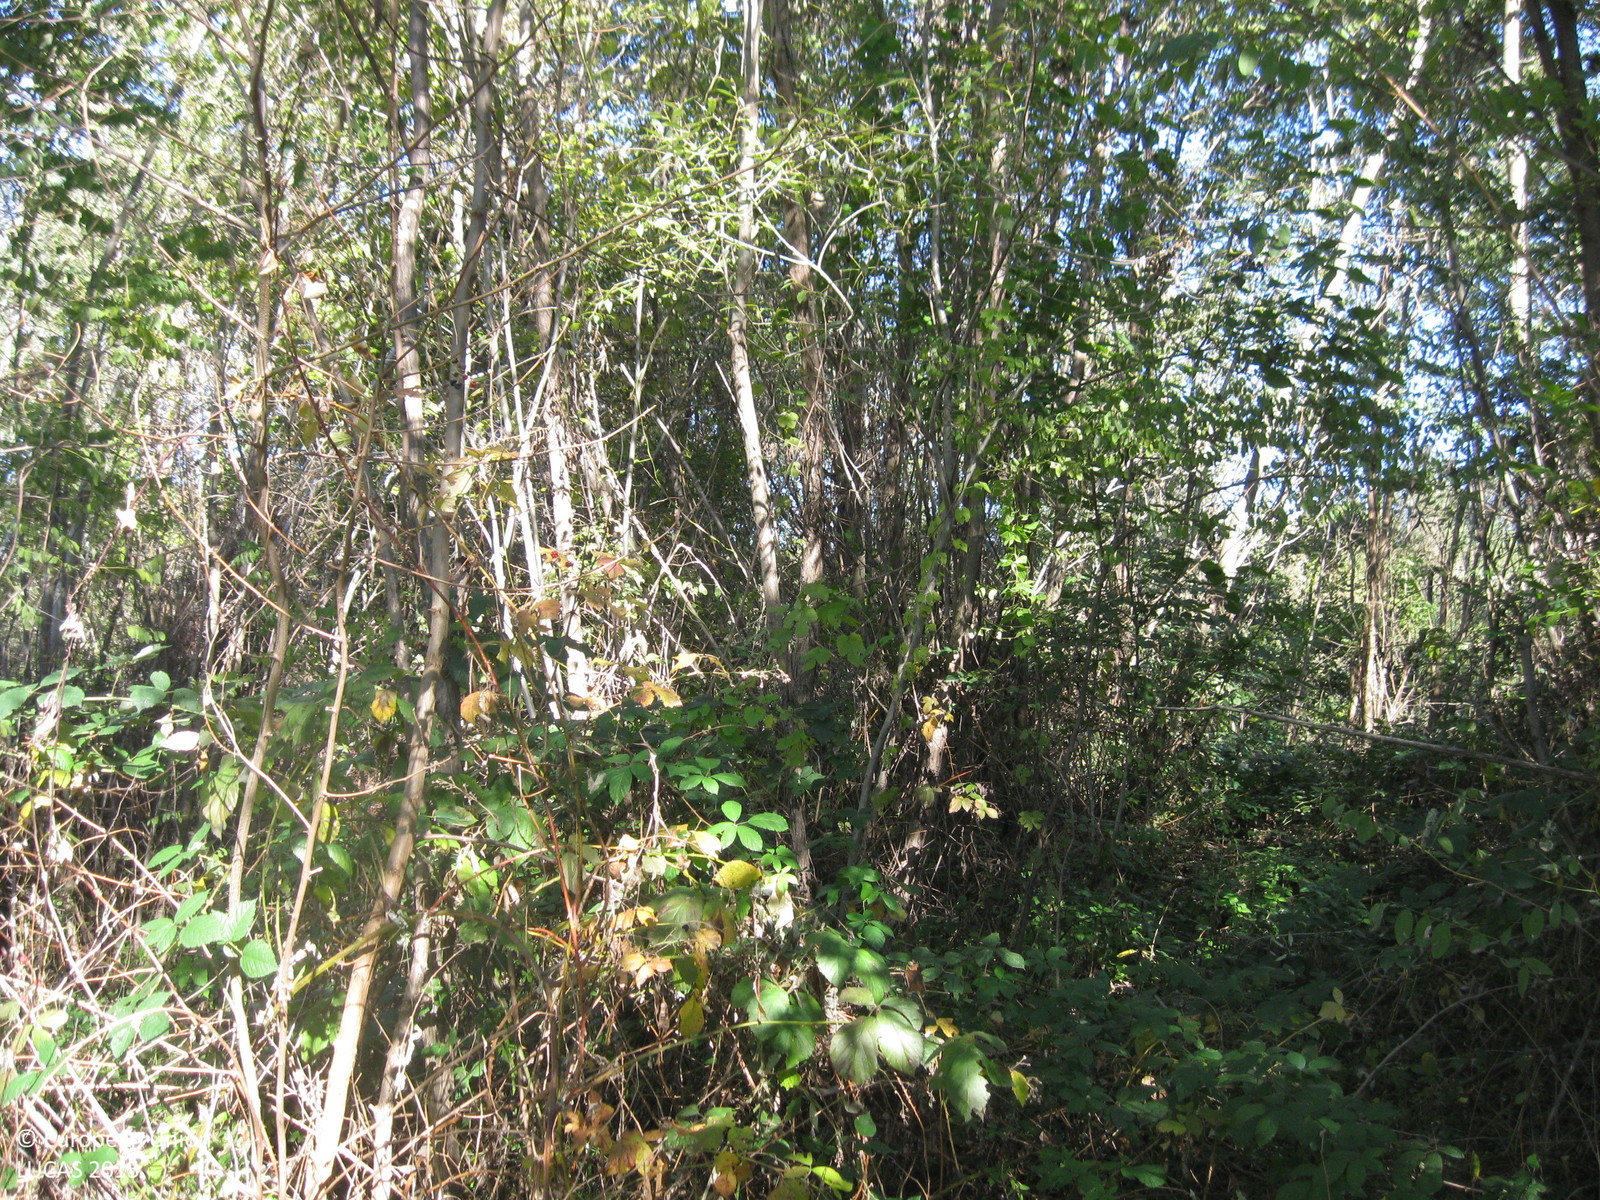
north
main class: Woodland
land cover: Broadleaved woodland
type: floodplain forest
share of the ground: > 75 %
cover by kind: broadleaved forest trees 90 %, shrubs 10 %
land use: Semi-natural and natural areas not in use
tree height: > 5 m
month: November
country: BG
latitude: 42.3835
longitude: 24.0465
